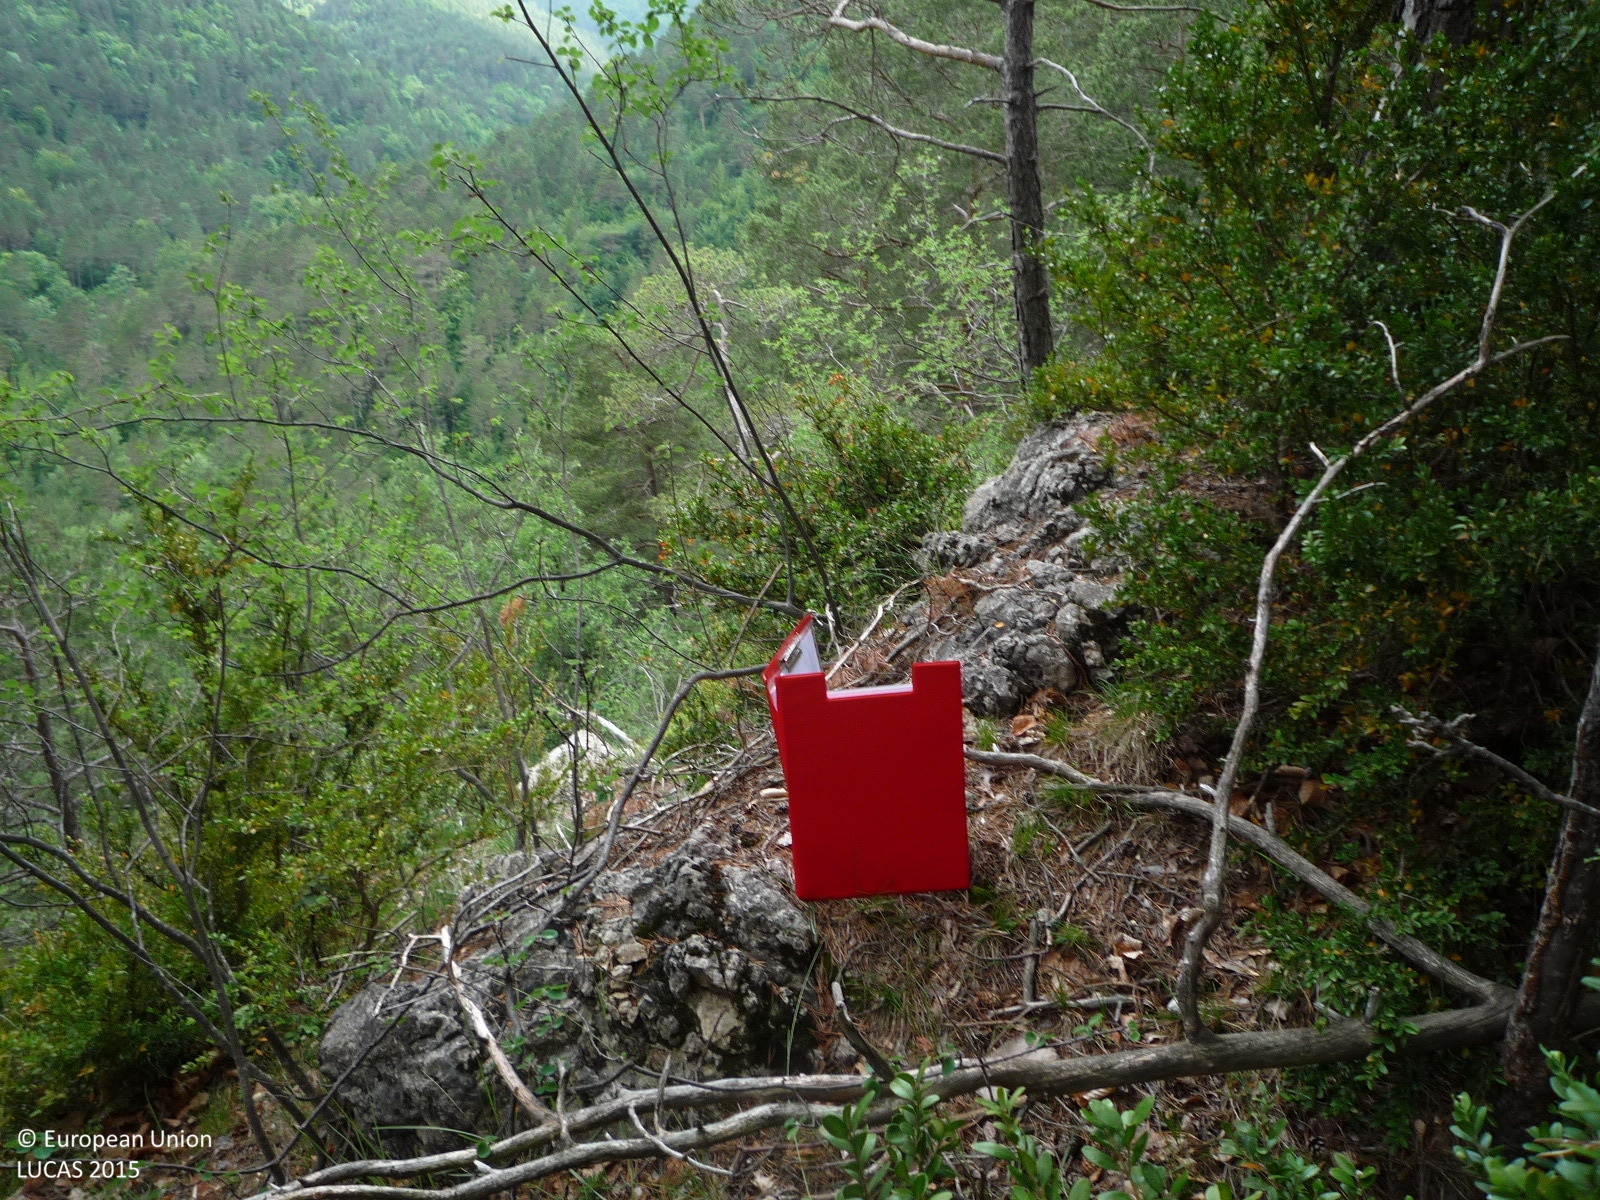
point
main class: Woodland
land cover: Pine dominated mixed woodland
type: alpine coniferous forest
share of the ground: > 75 %
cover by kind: coniferous forest trees 60 %, broadleaved forest trees 20 %, consolidated bare surface 20 %
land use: Forestry
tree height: > 5 m
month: June
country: ES
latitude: 42.2248
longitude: 1.9556
